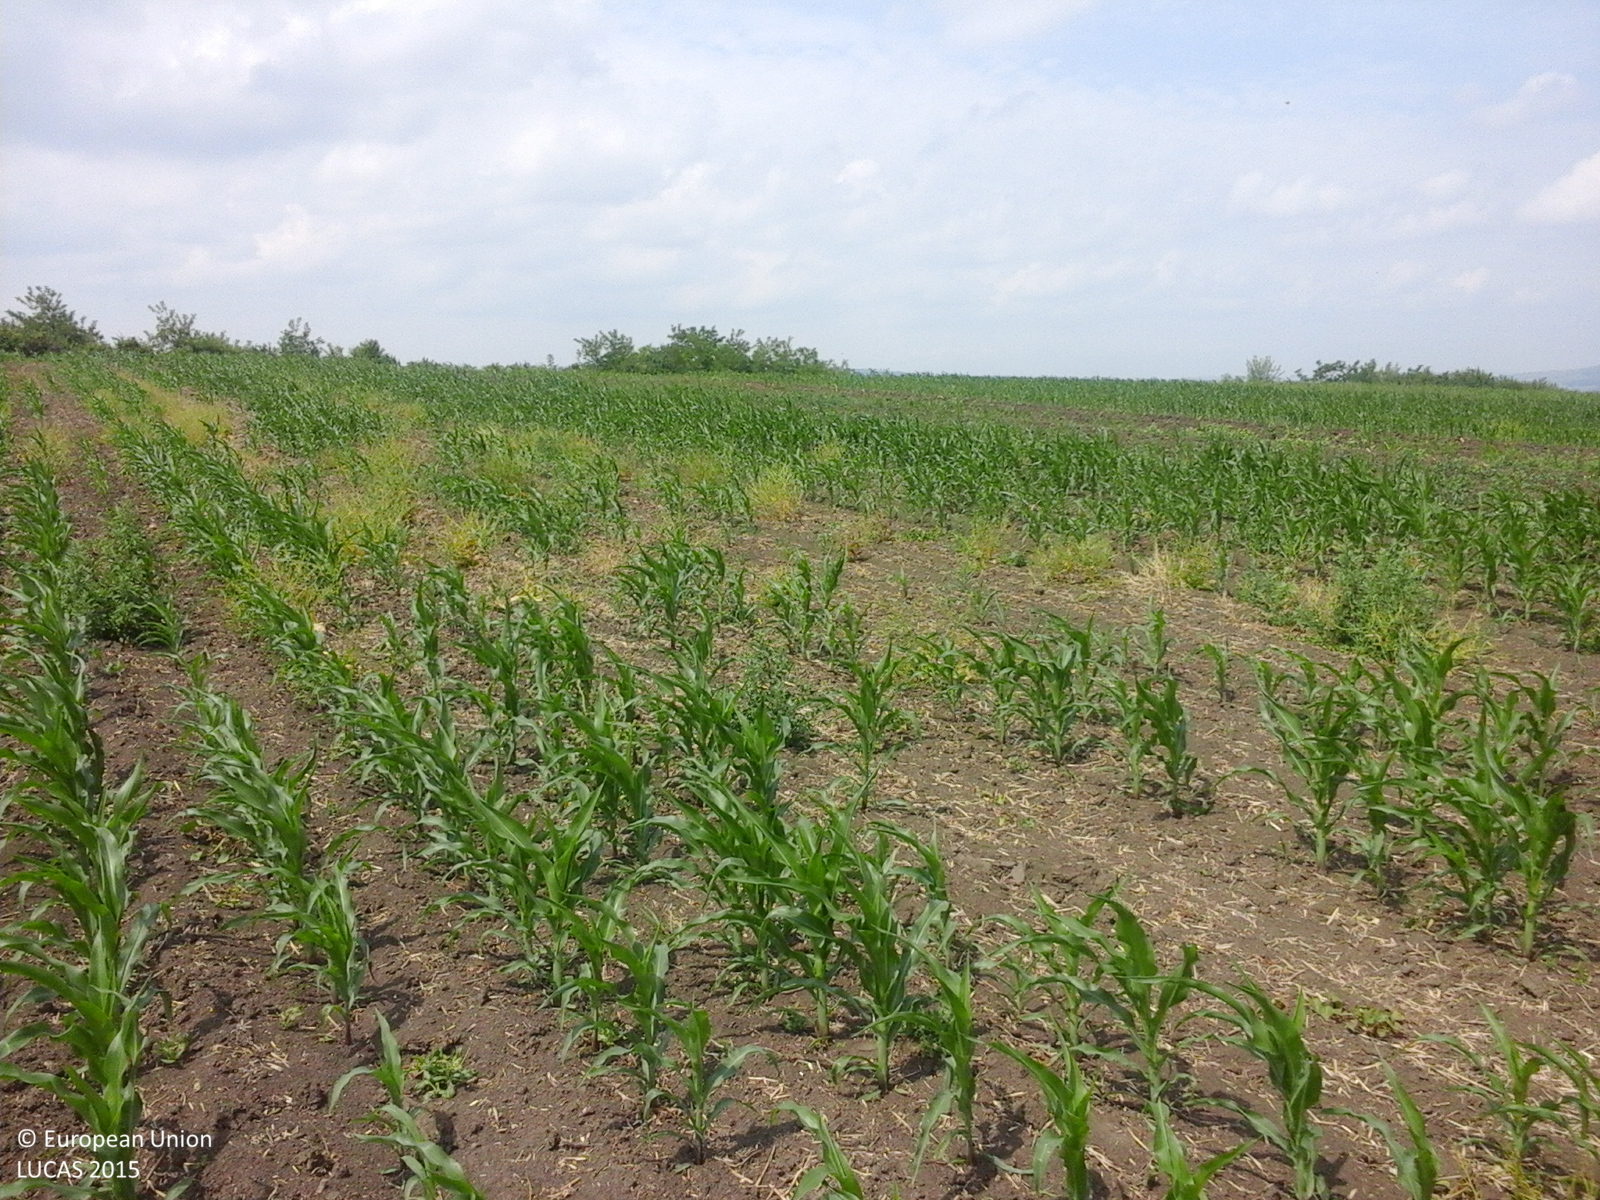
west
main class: Cropland
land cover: Maize
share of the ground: 10 - 25 %
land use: Agriculture (excluding fallow land and kitchen gardens)
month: June
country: RO
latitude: 47.3878
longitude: 26.9922
